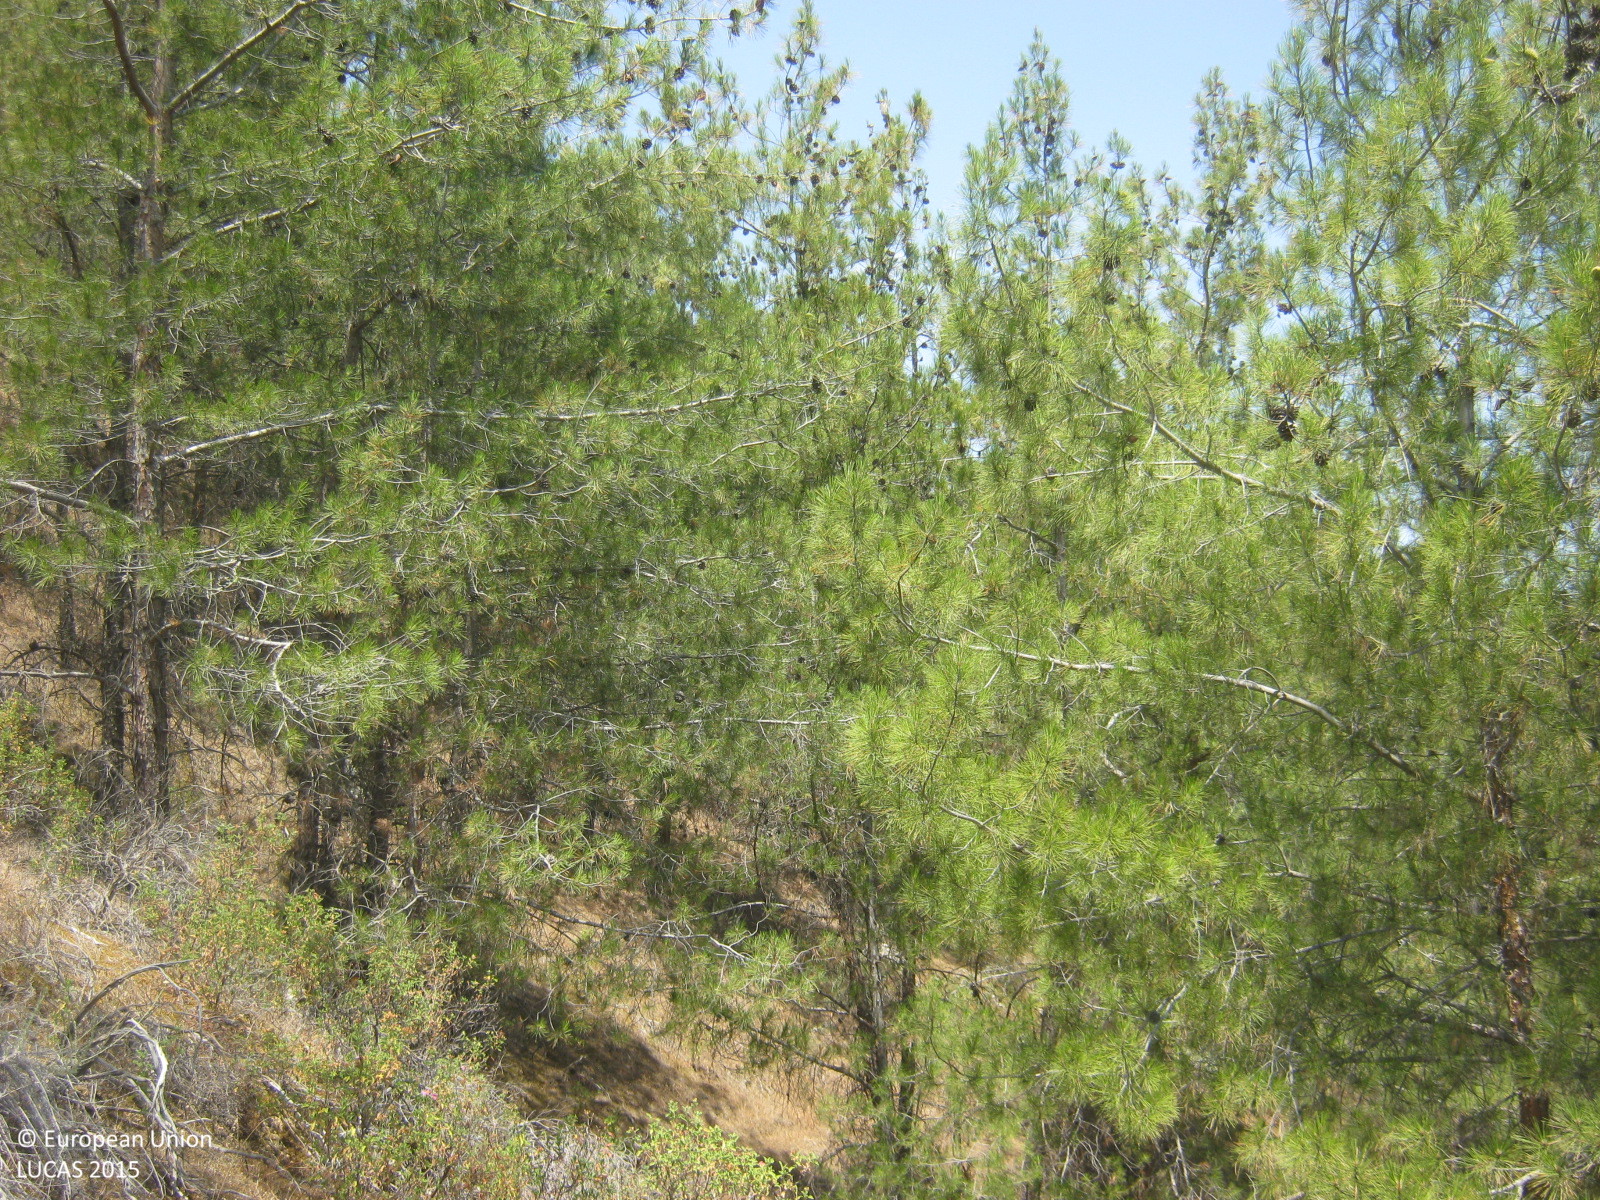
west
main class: Woodland
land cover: Pine dominated coniferous woodland
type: coniferous forest of the mediterranean region
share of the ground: > 75 %
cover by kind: coniferous forest trees 80 %, shrubs 10 %, unconsolidated bare surface 10 %
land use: Forestry
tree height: > 5 m
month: June
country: CY
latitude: 35.0183
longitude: 33.0026
